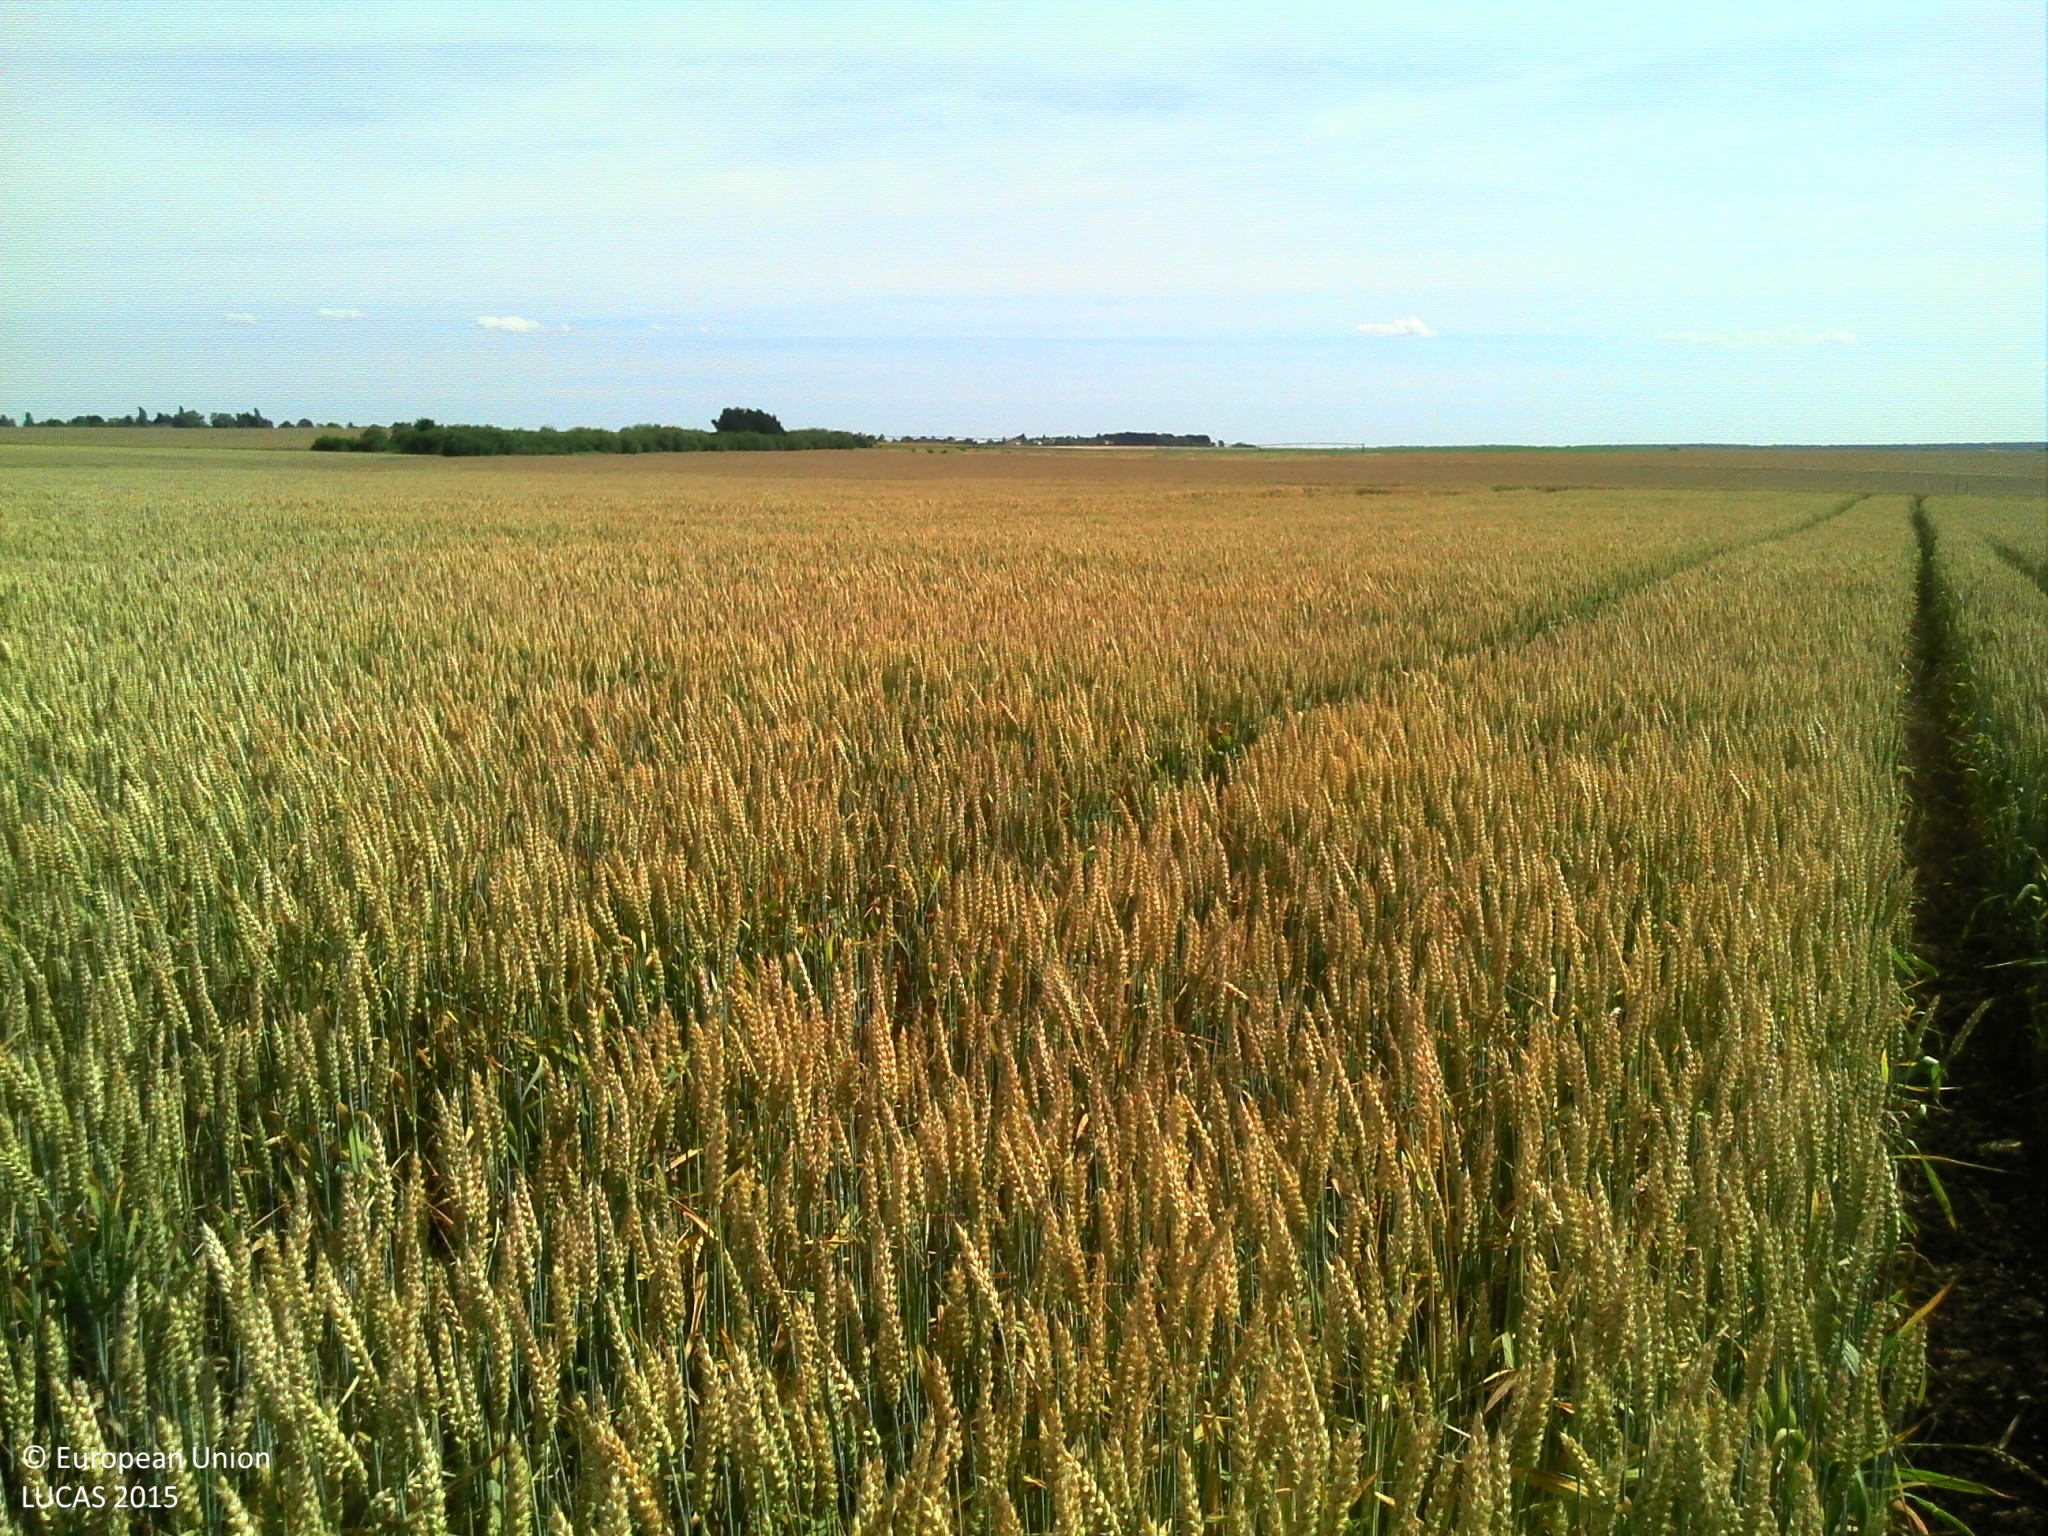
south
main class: Cropland
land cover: Common wheat
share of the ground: > 75 %
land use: Agriculture (excluding fallow land and kitchen gardens)
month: June
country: FR
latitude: 46.6634
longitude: 0.2166
